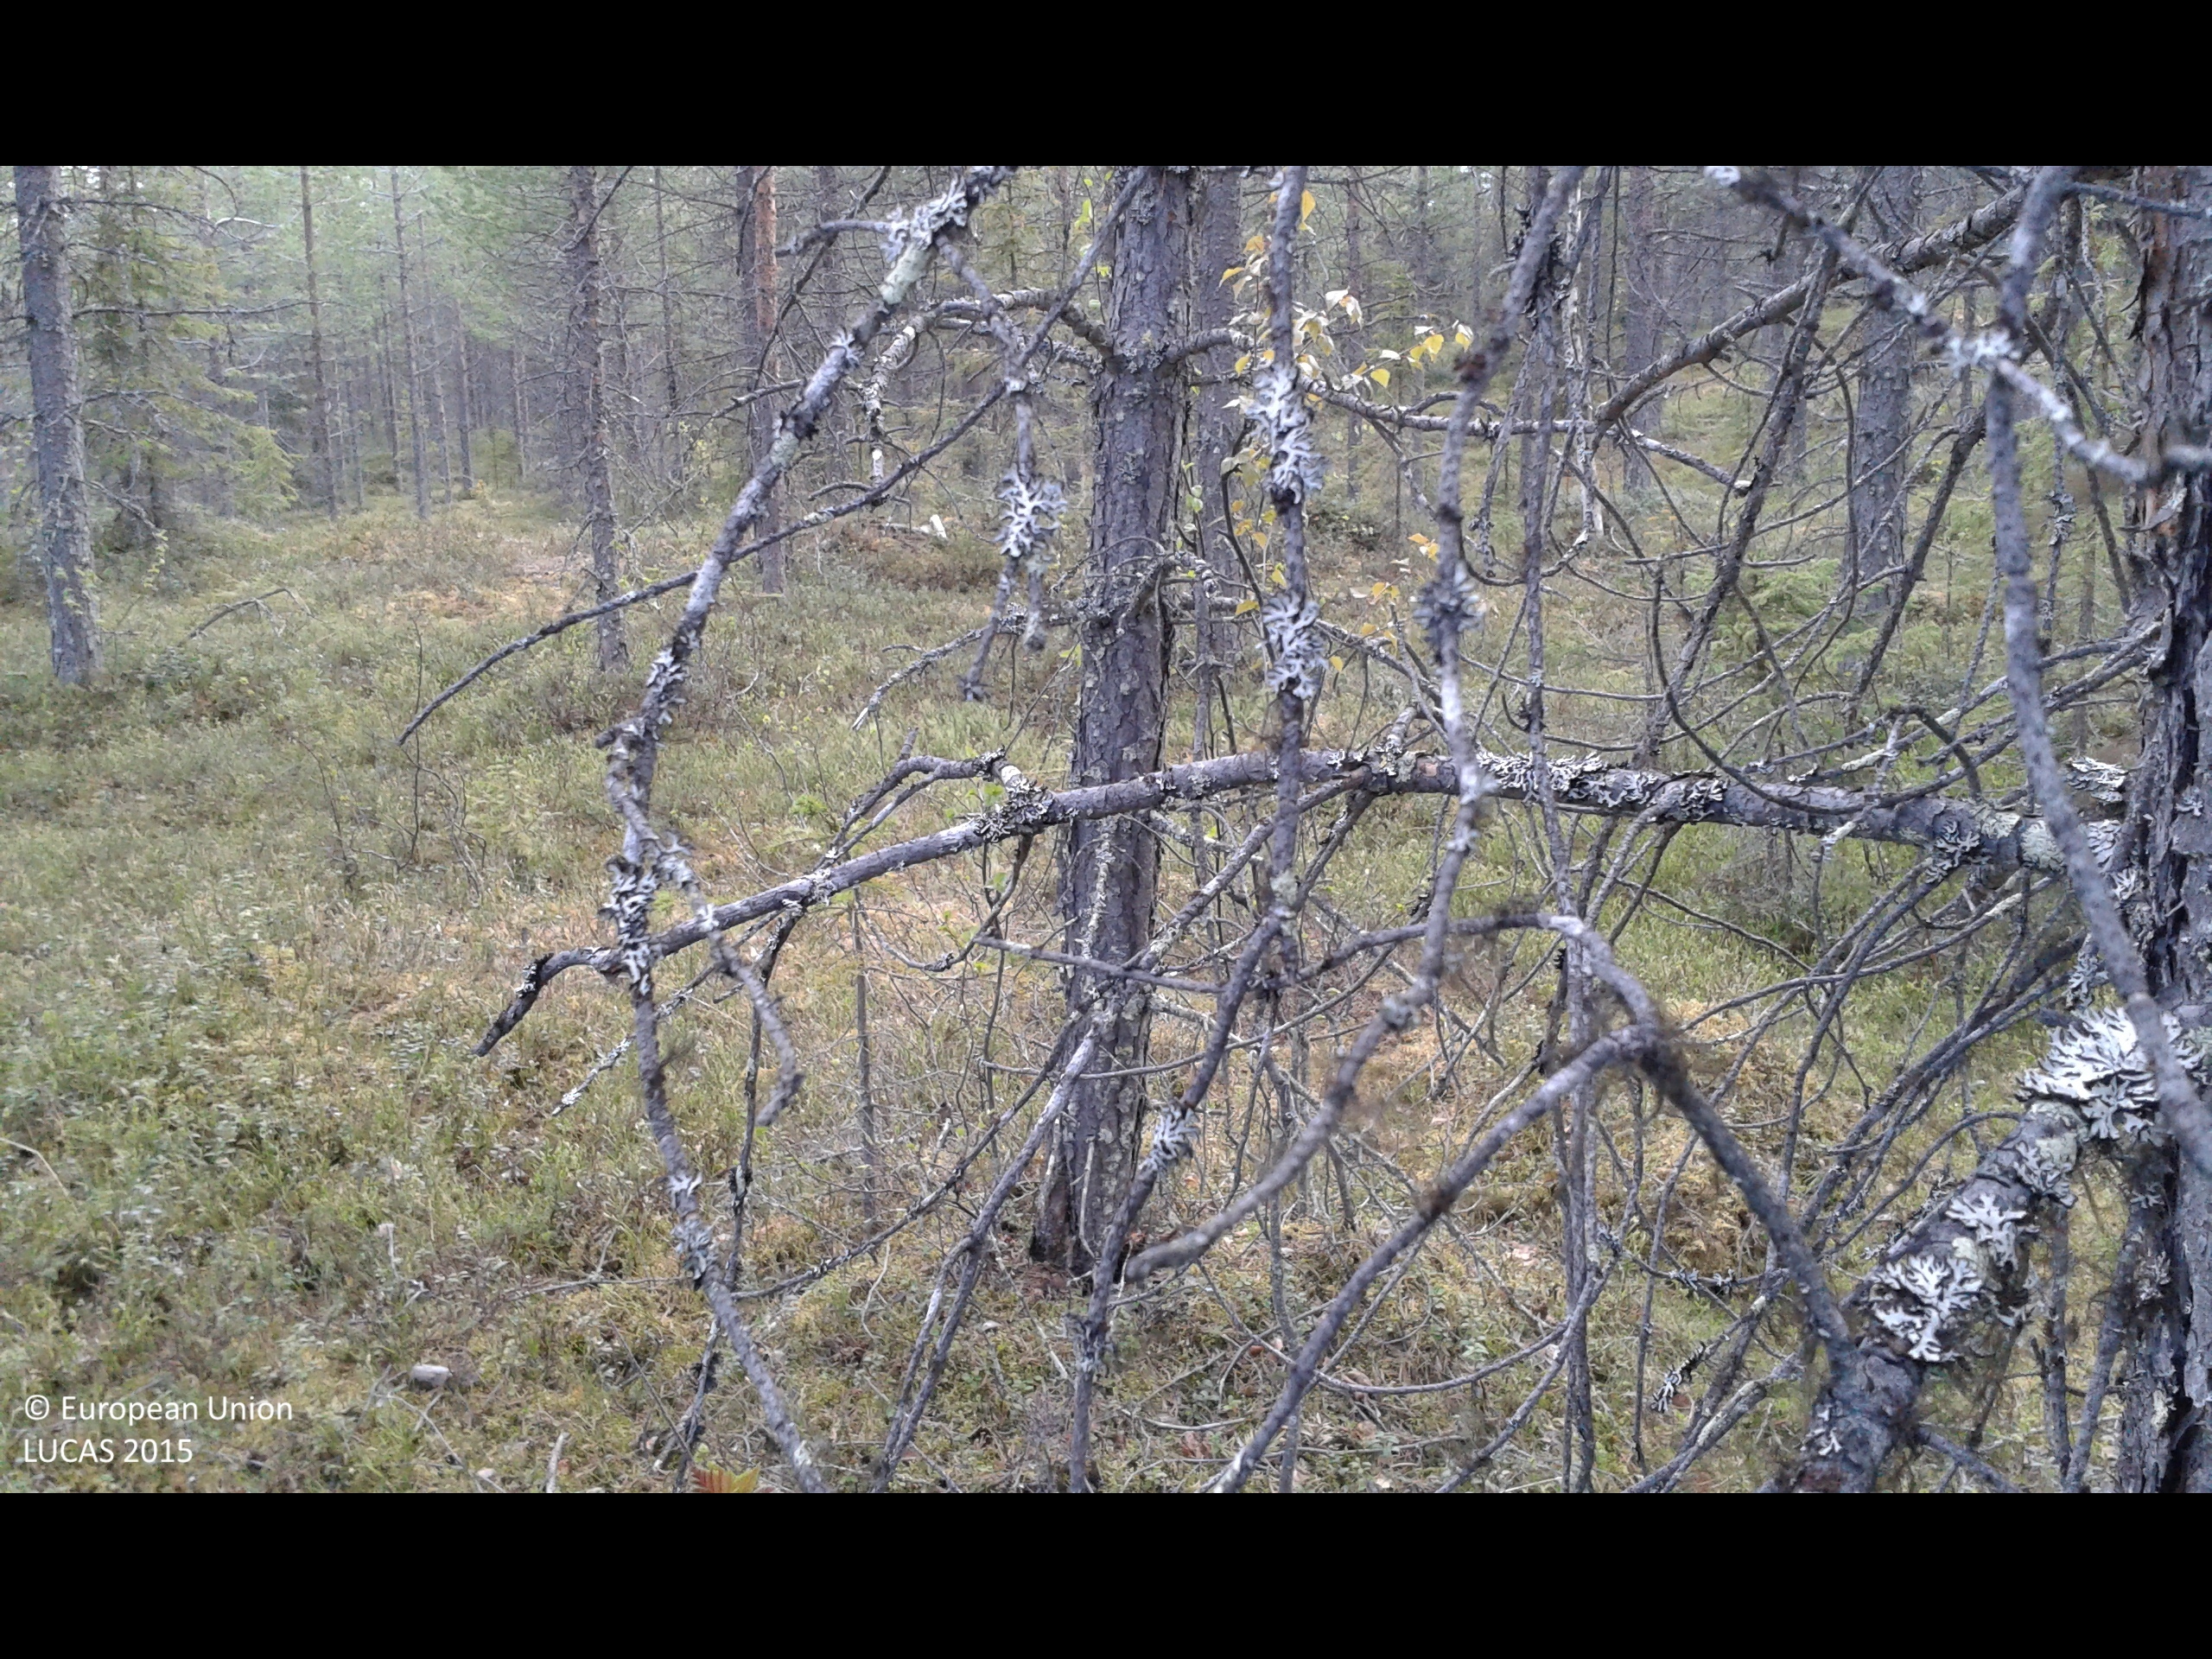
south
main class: Woodland
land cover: Pine dominated coniferous woodland
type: boreal forest
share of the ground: 25 - 50 %
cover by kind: herbaceous plants 55 %, coniferous forest trees 40 %, lichens and mosses 5 %
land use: Forestry
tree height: > 5 m
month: June
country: SE
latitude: 66.9508
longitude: 21.1468
